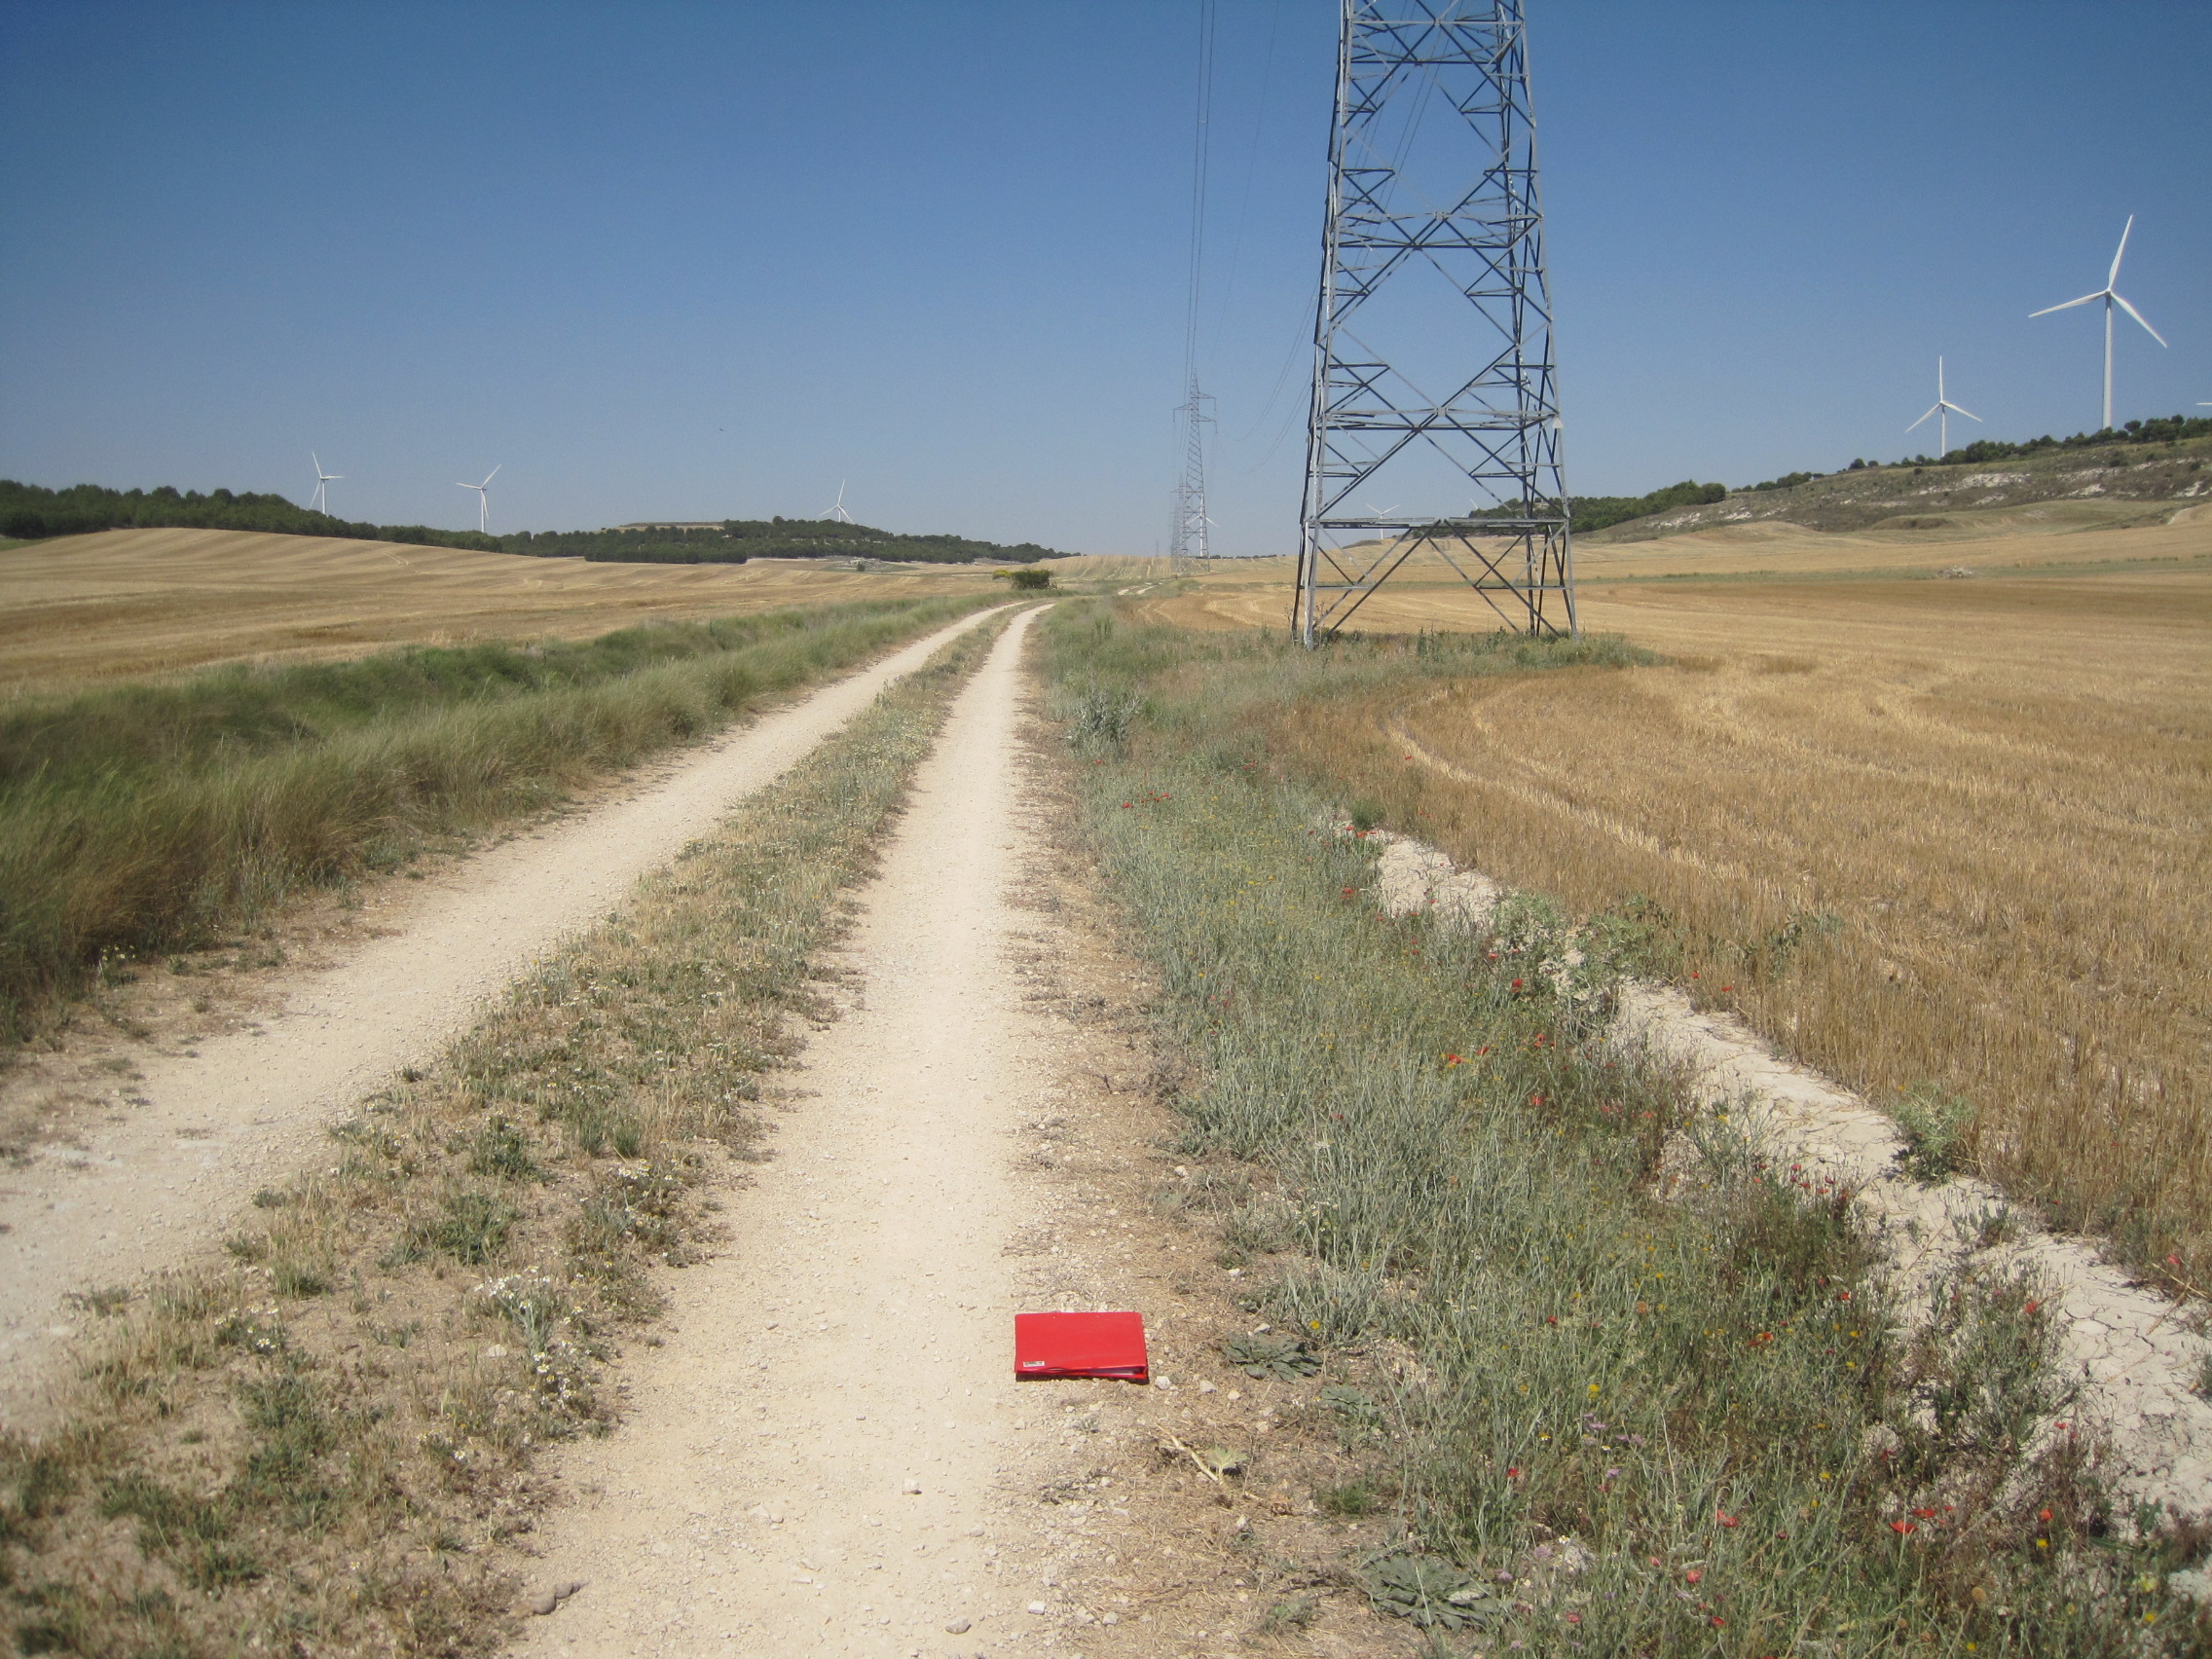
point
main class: Cropland
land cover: Common wheat
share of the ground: < 10 %
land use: Agriculture (excluding fallow land and kitchen gardens)
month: July
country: ES
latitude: 41.9338
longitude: -4.7505
